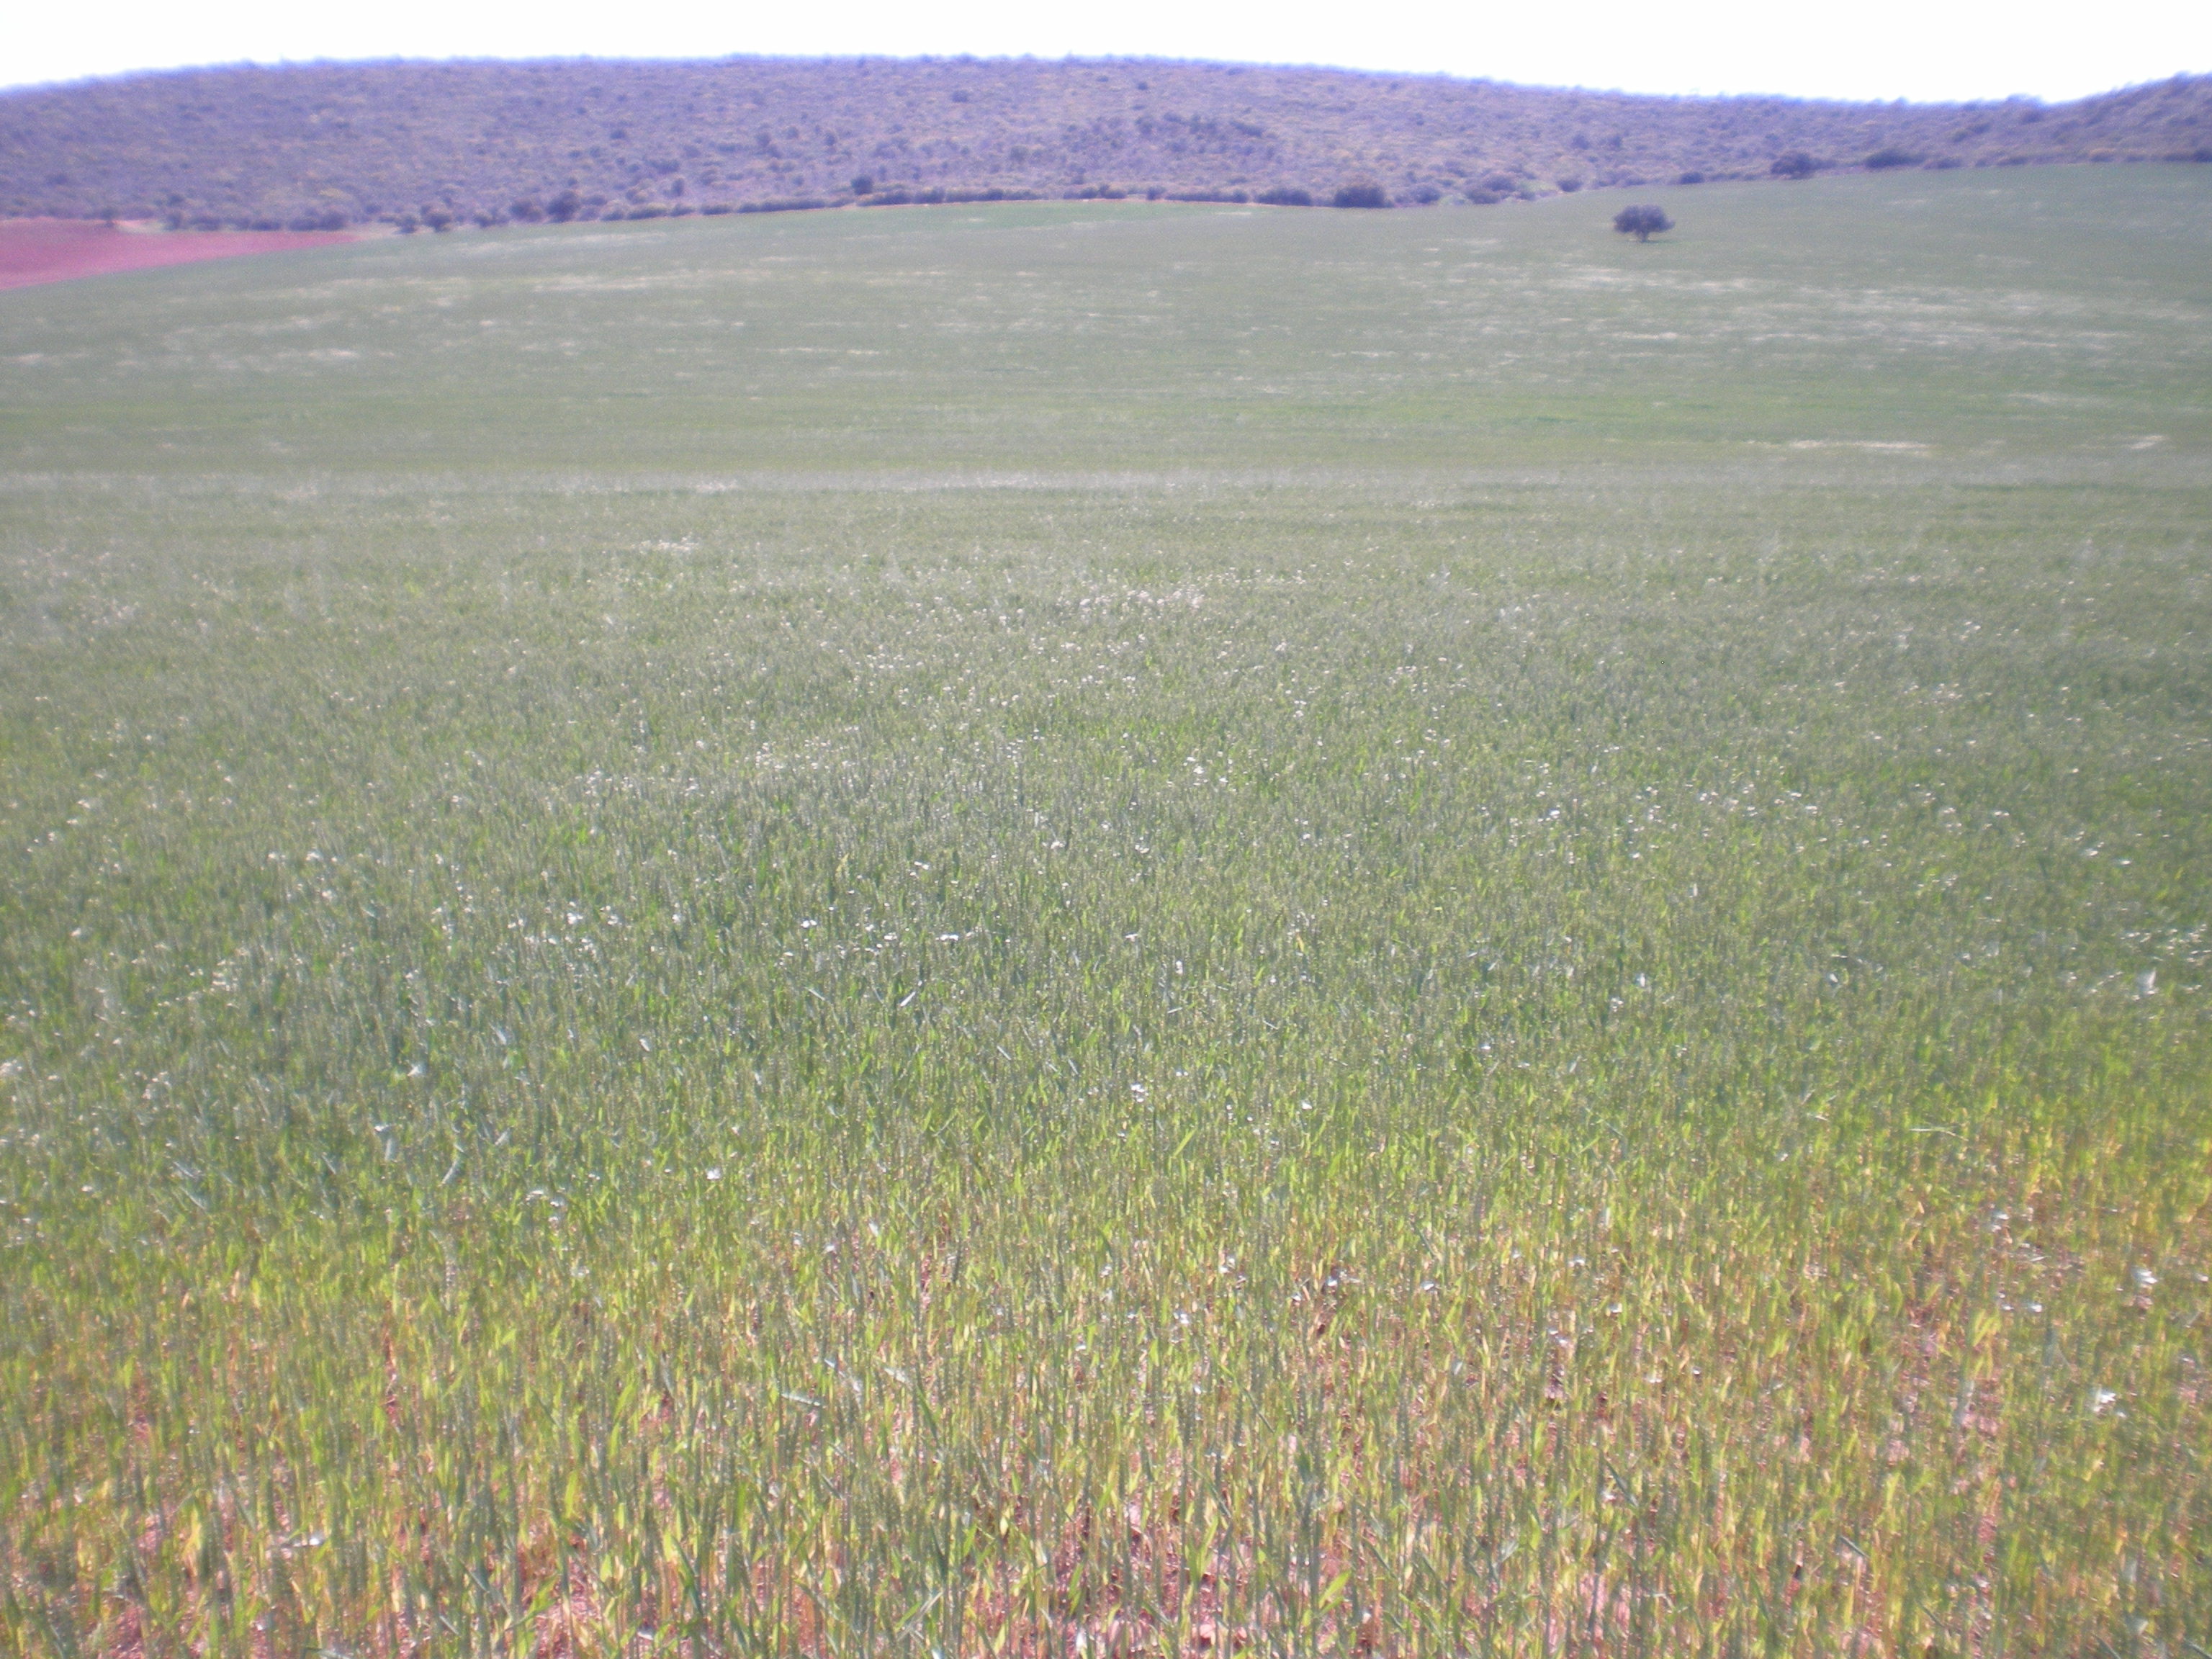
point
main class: Cropland
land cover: Common wheat
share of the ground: > 75 %
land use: Agriculture (excluding fallow land and kitchen gardens)
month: April
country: ES
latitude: 38.7503
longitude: -3.5789
